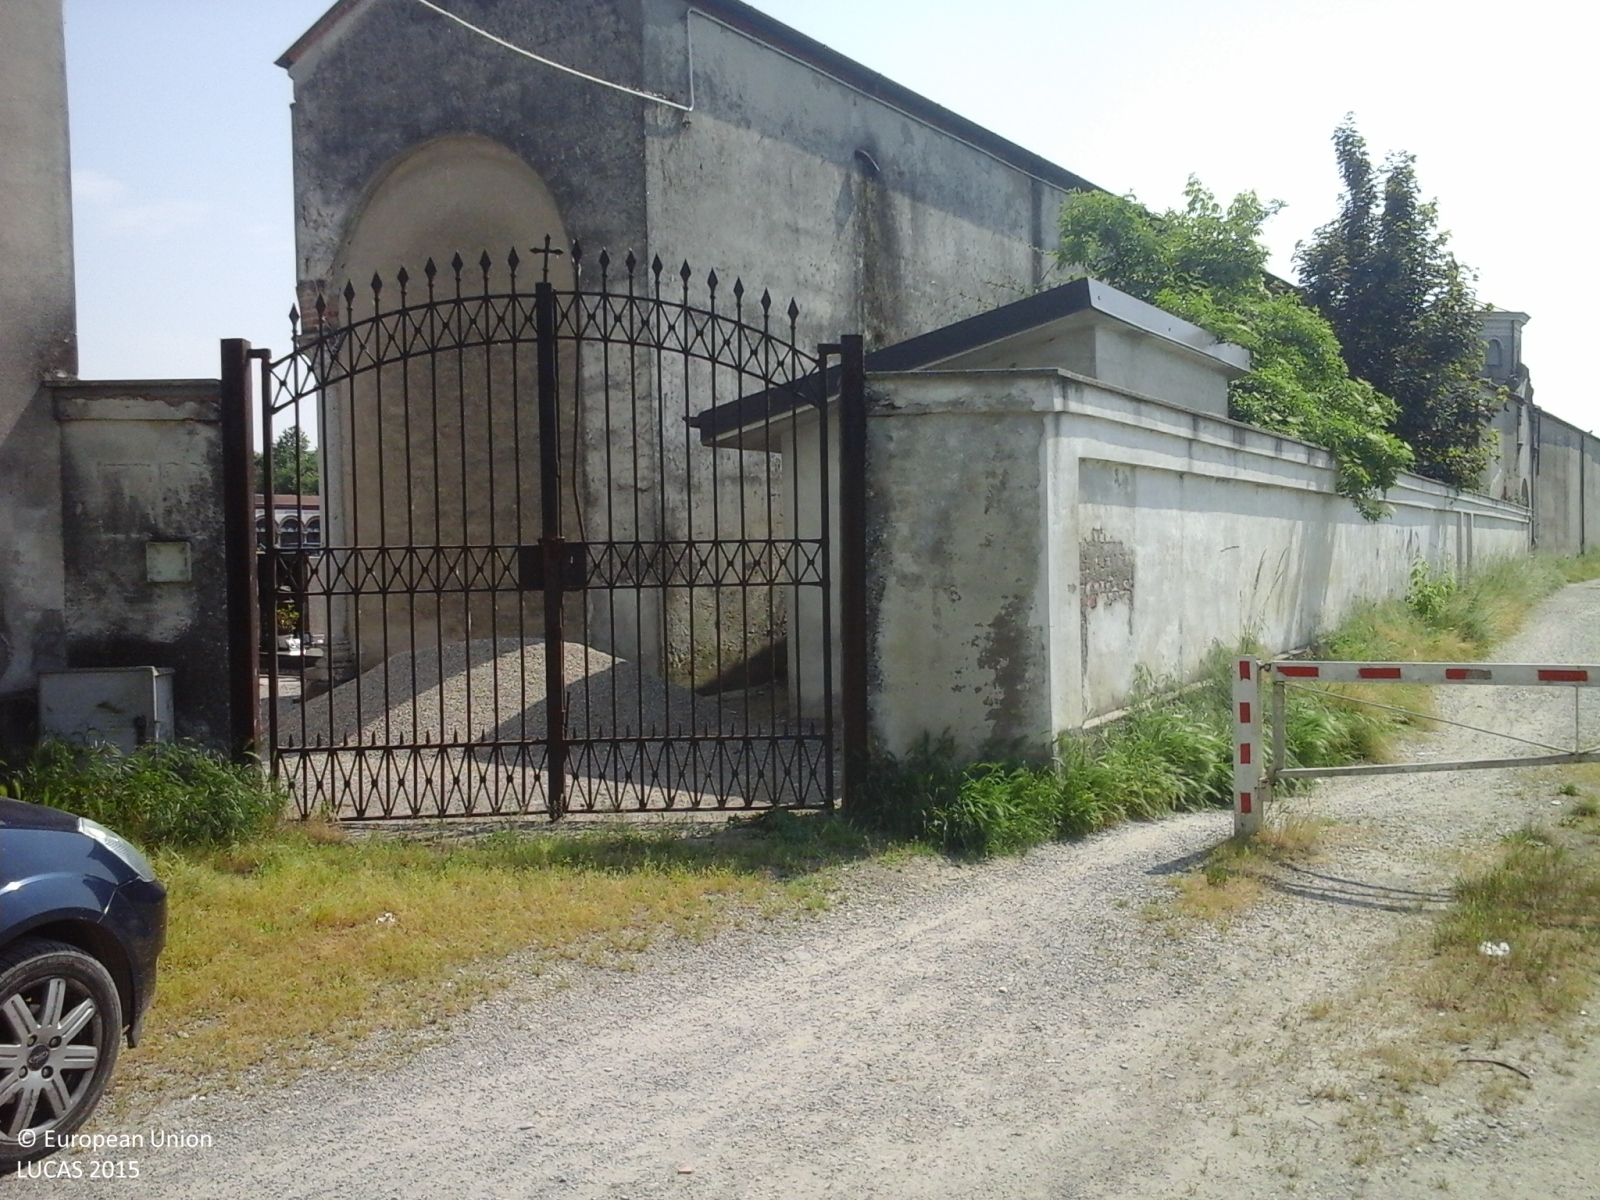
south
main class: Cropland
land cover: Barley
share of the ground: > 75 %
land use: Agriculture (excluding fallow land and kitchen gardens)
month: May
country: IT
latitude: 45.2323
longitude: 9.4024
